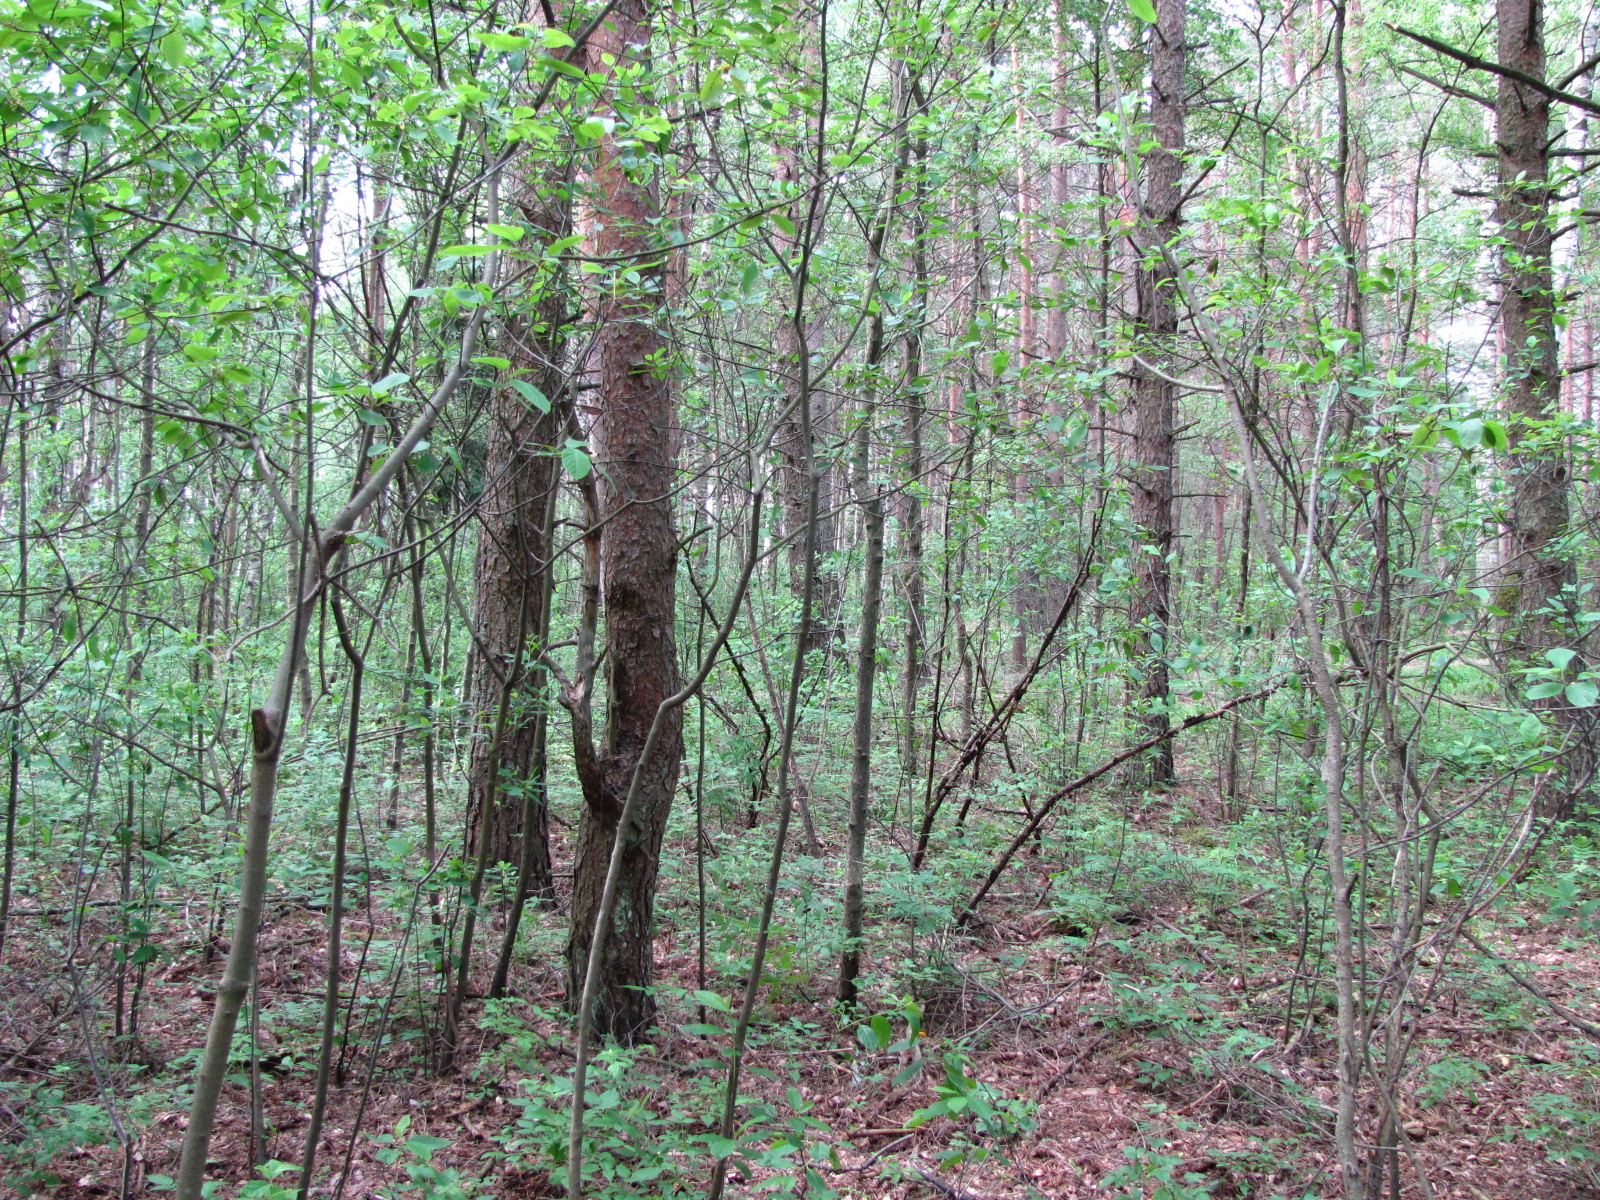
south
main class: Woodland
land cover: Pine dominated mixed woodland
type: mire and swamp forests
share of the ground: > 75 %
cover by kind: coniferous forest trees 70 %, broadleaved forest trees 30 %
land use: Forestry
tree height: > 5 m
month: June
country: LV
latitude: 56.8726
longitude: 23.8789
